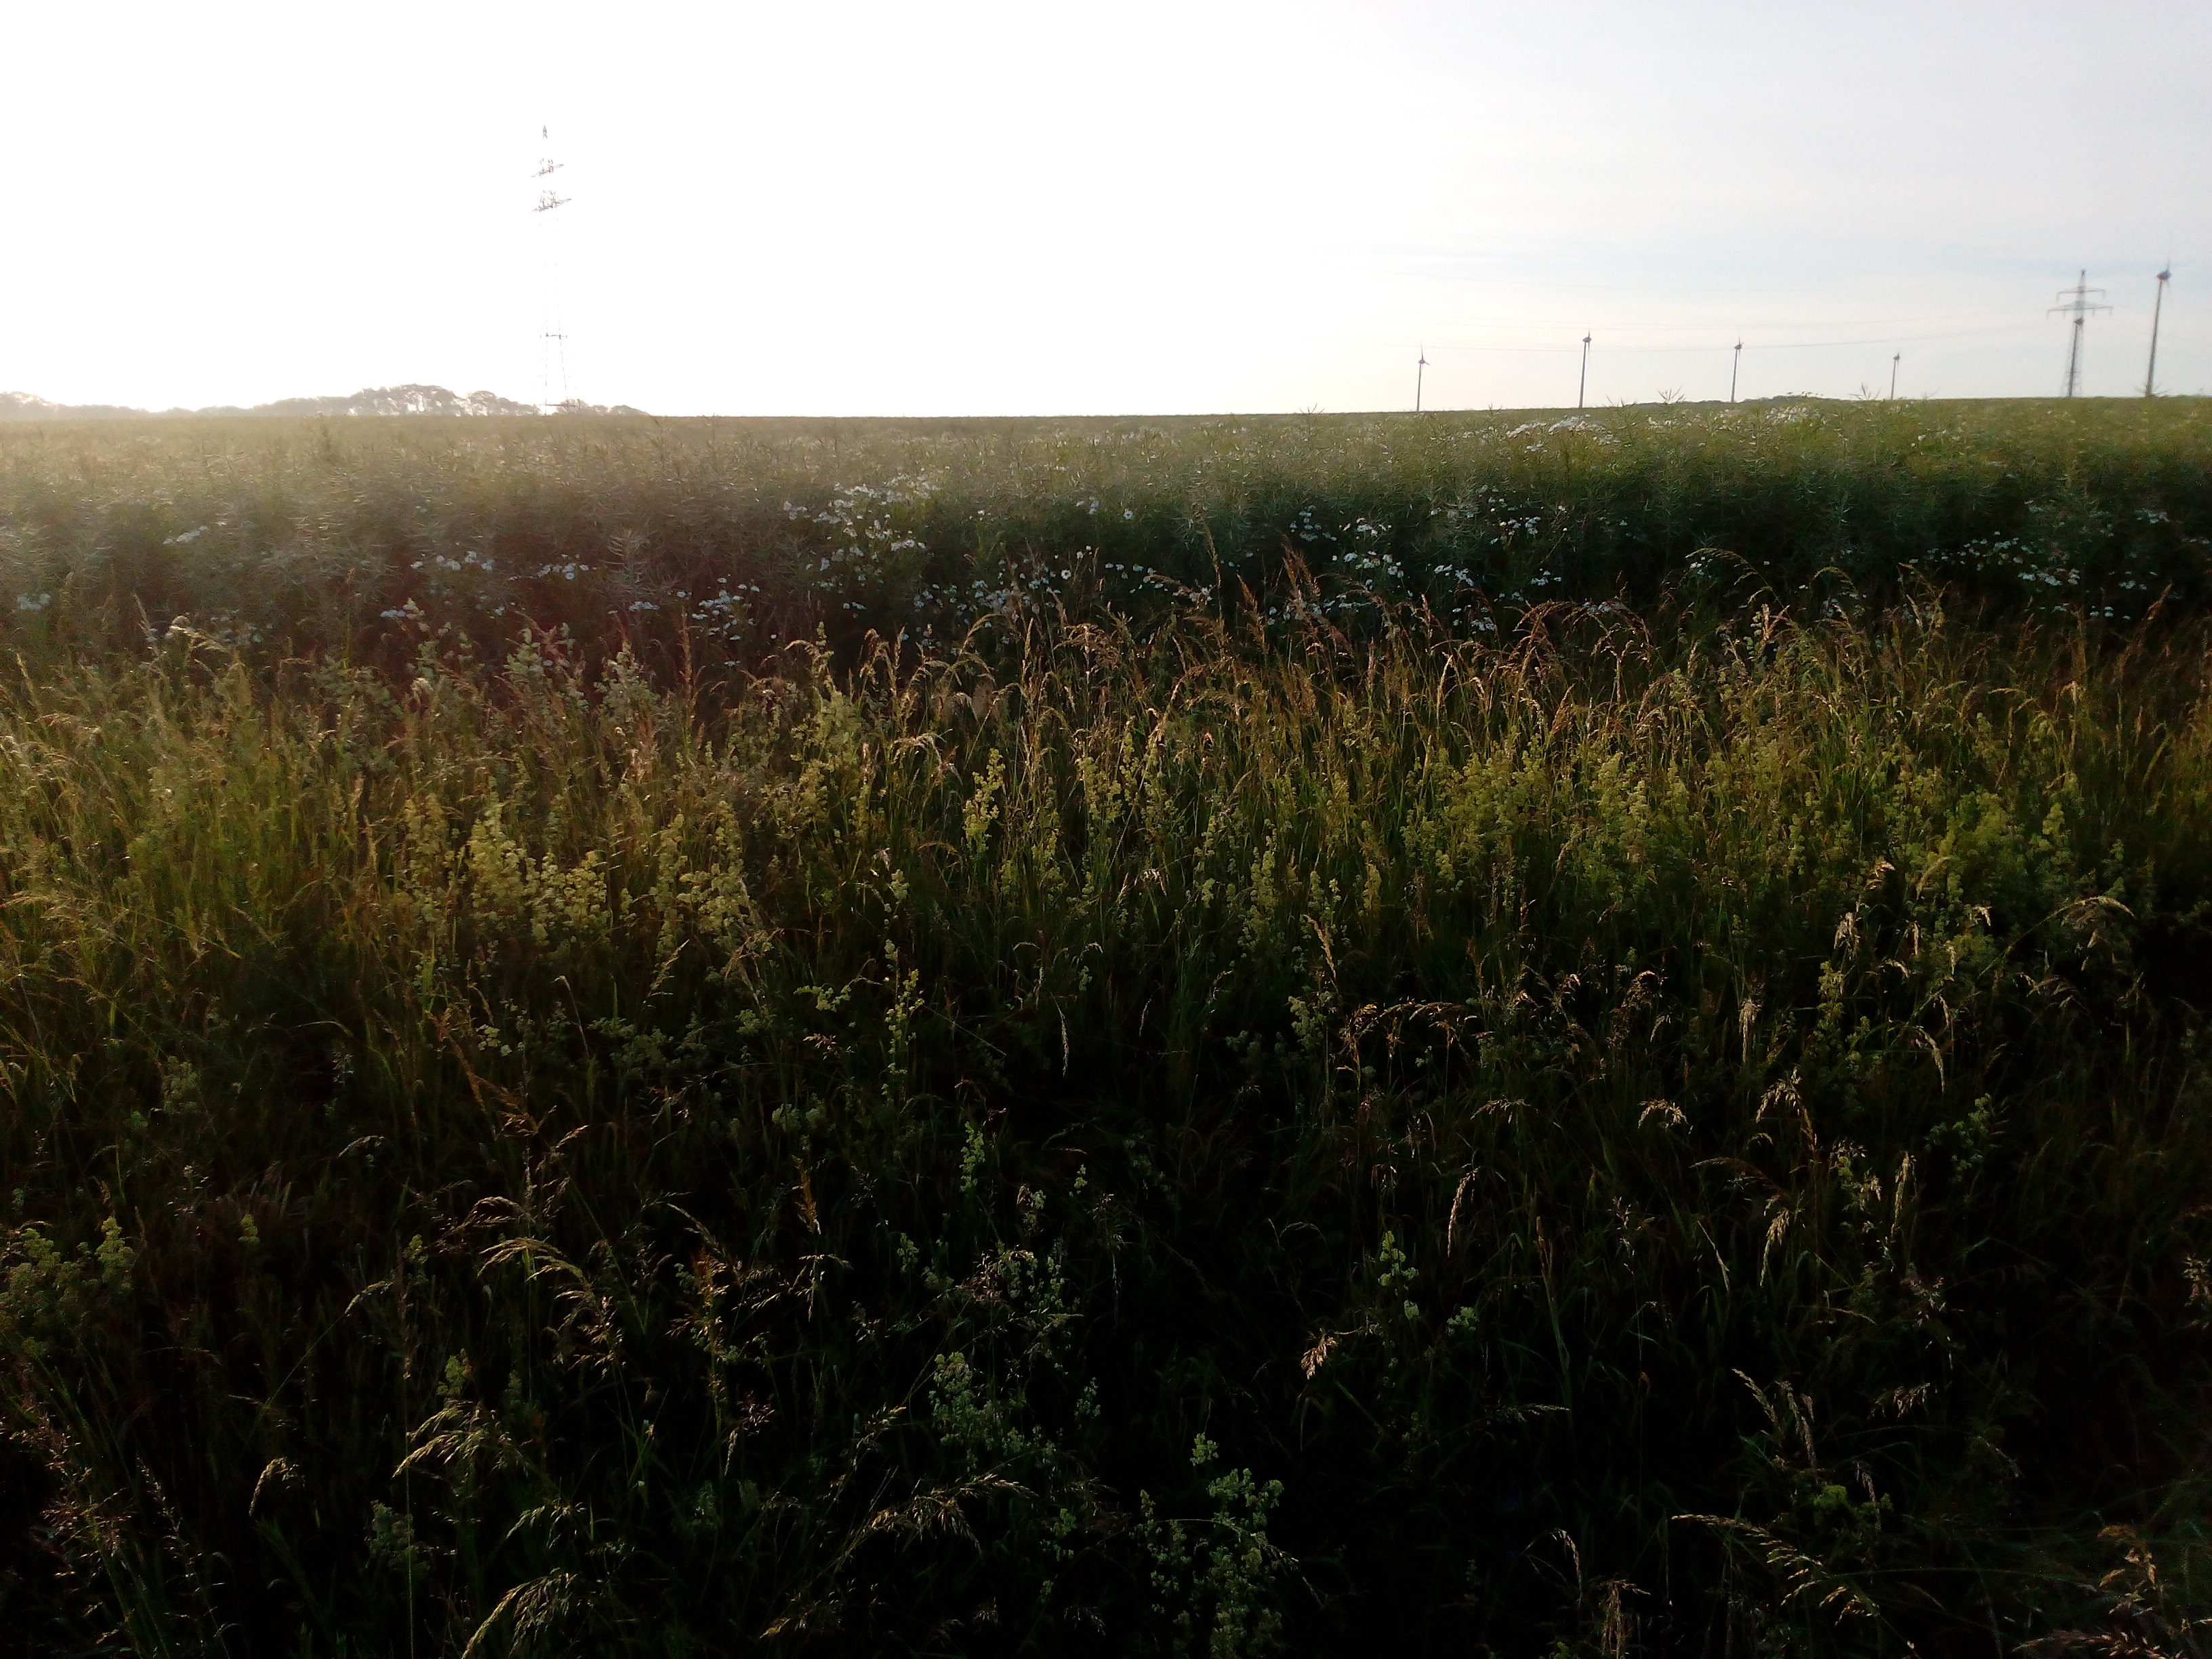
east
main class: Cropland
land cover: Rape and turnip rape
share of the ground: > 75 %
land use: Agriculture (excluding fallow land and kitchen gardens)
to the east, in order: Rape and turnip rape; Grassland without tree/shrub cover; Ditches and canals; Grass margins; Tracks; Grass margins; Rape and turnip rape
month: June
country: DE
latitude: 50.8089
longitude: 11.0357
